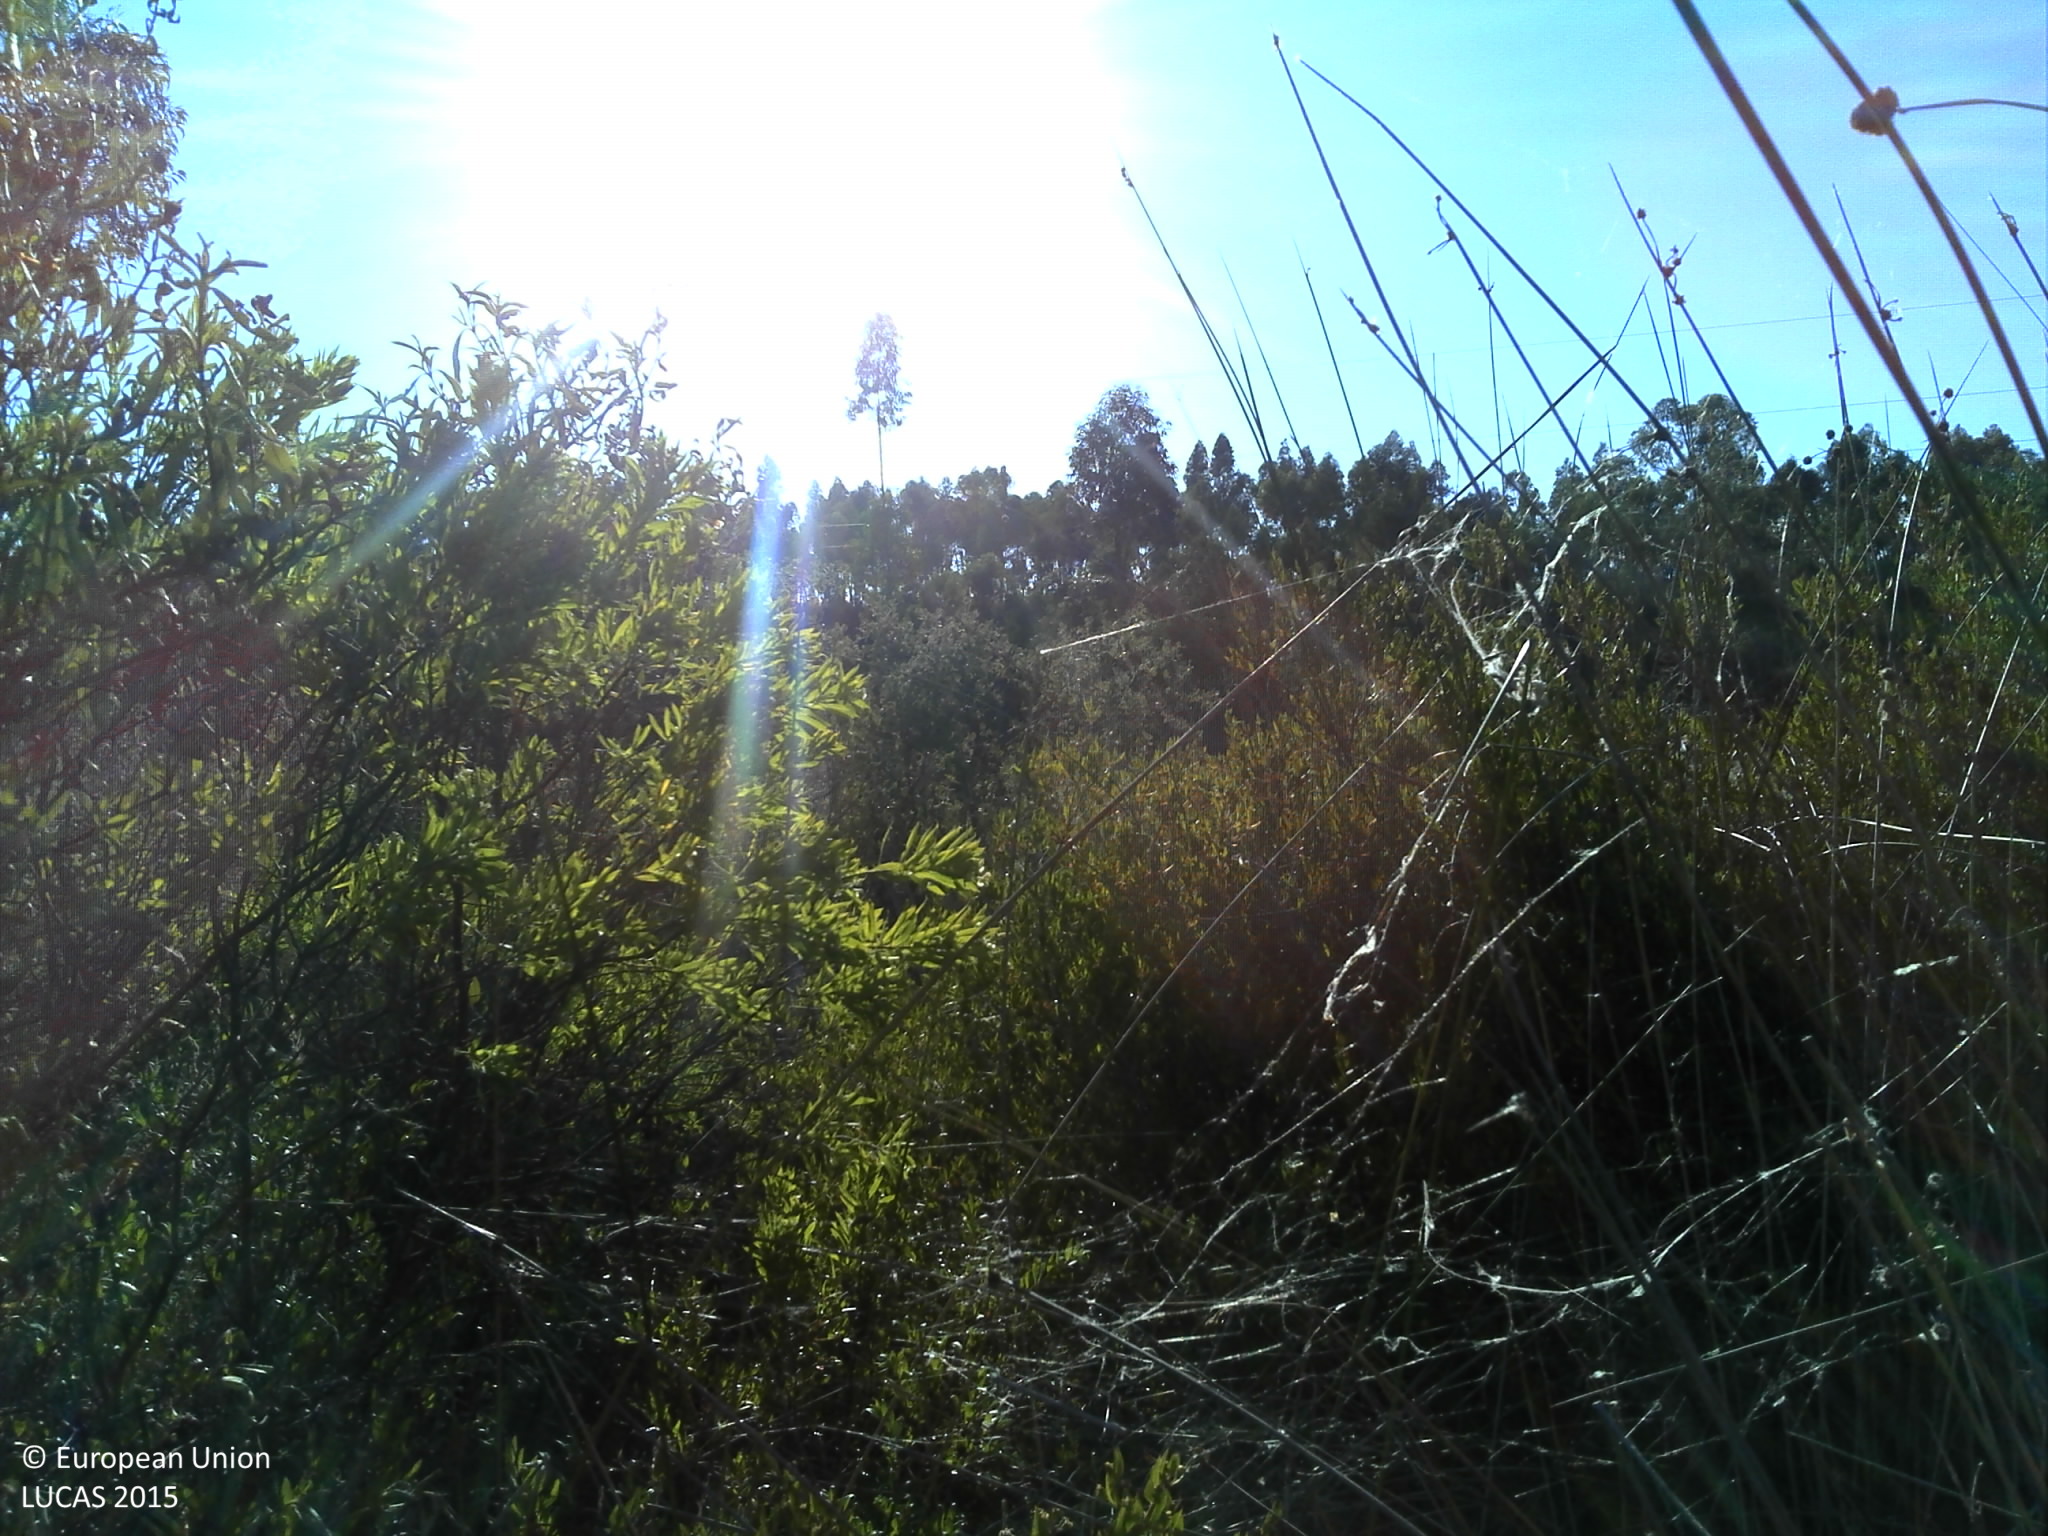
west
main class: Woodland
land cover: Broadleaved woodland
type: exotic forest
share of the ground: 10 - 25 %
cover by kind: shrubs 85 %, broadleaved forest trees 15 %
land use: Forestry
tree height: > 5 m
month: August
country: PT
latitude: 39.6043
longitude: -7.6977
